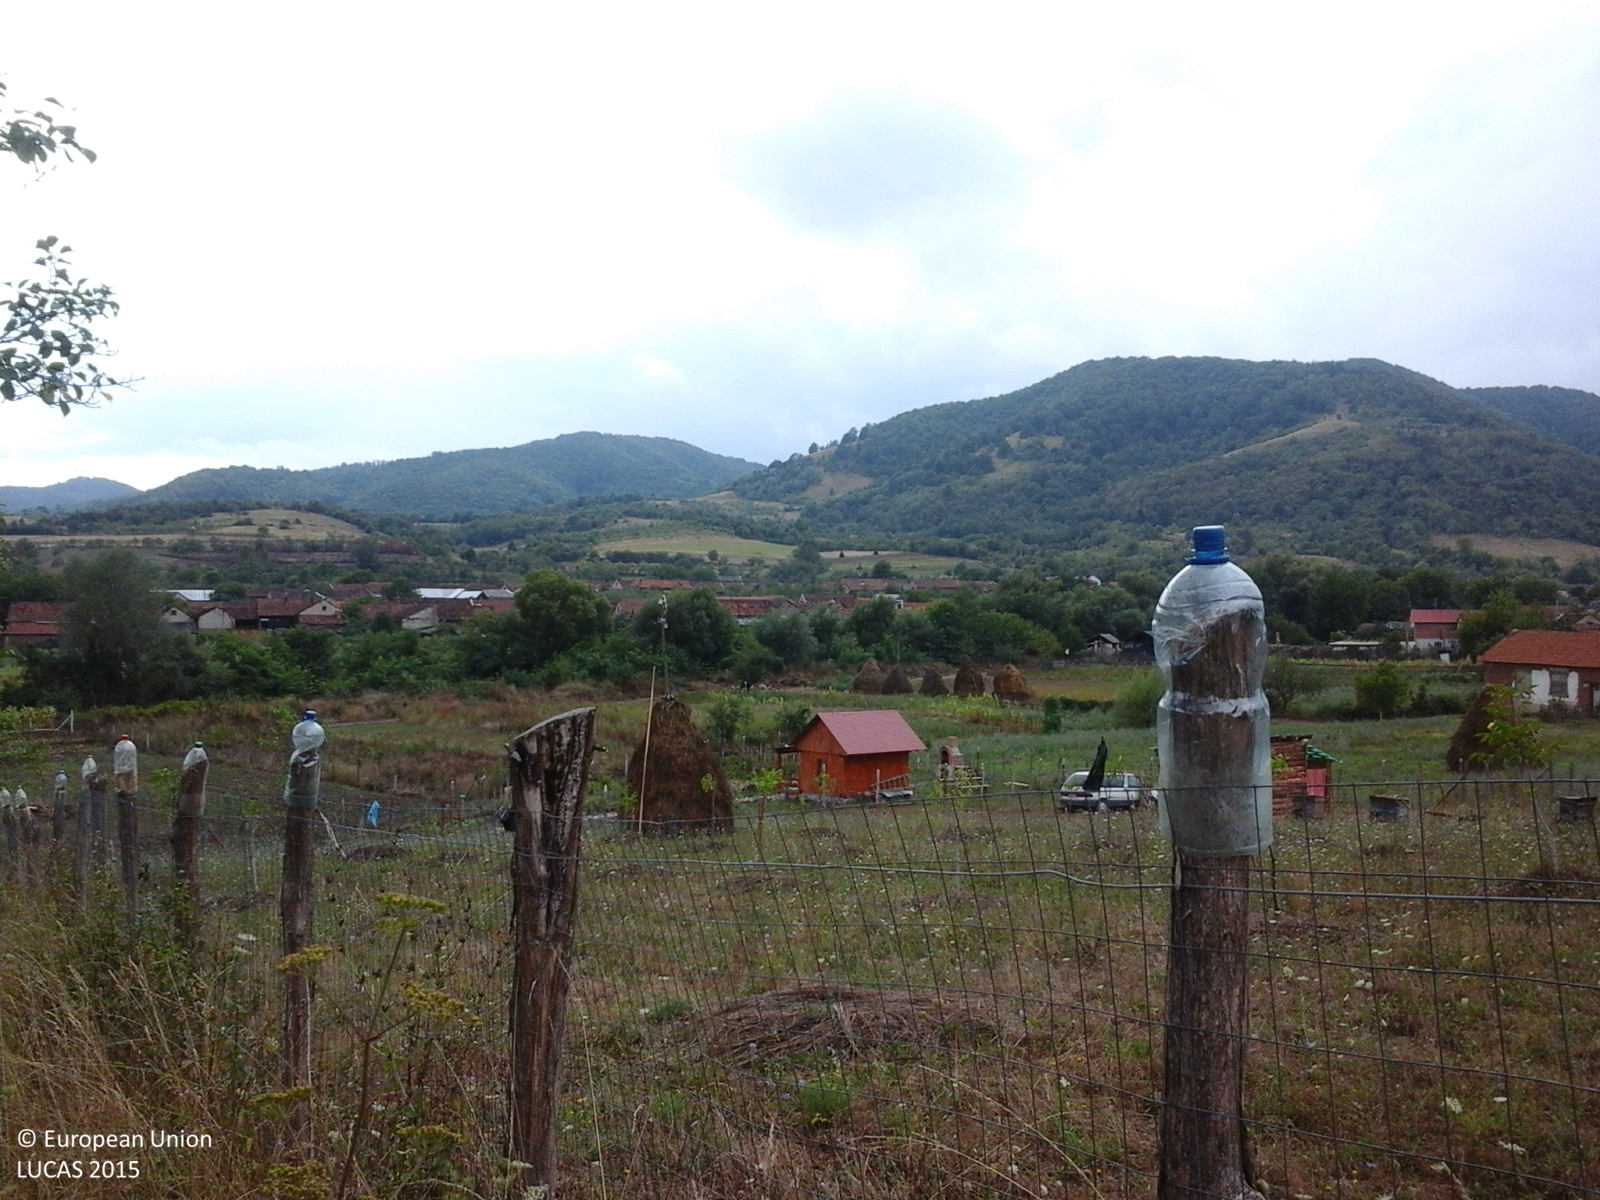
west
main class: Cropland
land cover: Nuts trees
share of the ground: 25 - 50 %
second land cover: Grassland without tree/shrub cover
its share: > 75 %
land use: Agriculture (excluding fallow land and kitchen gardens)
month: August
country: RO
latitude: 44.8959
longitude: 21.9498
